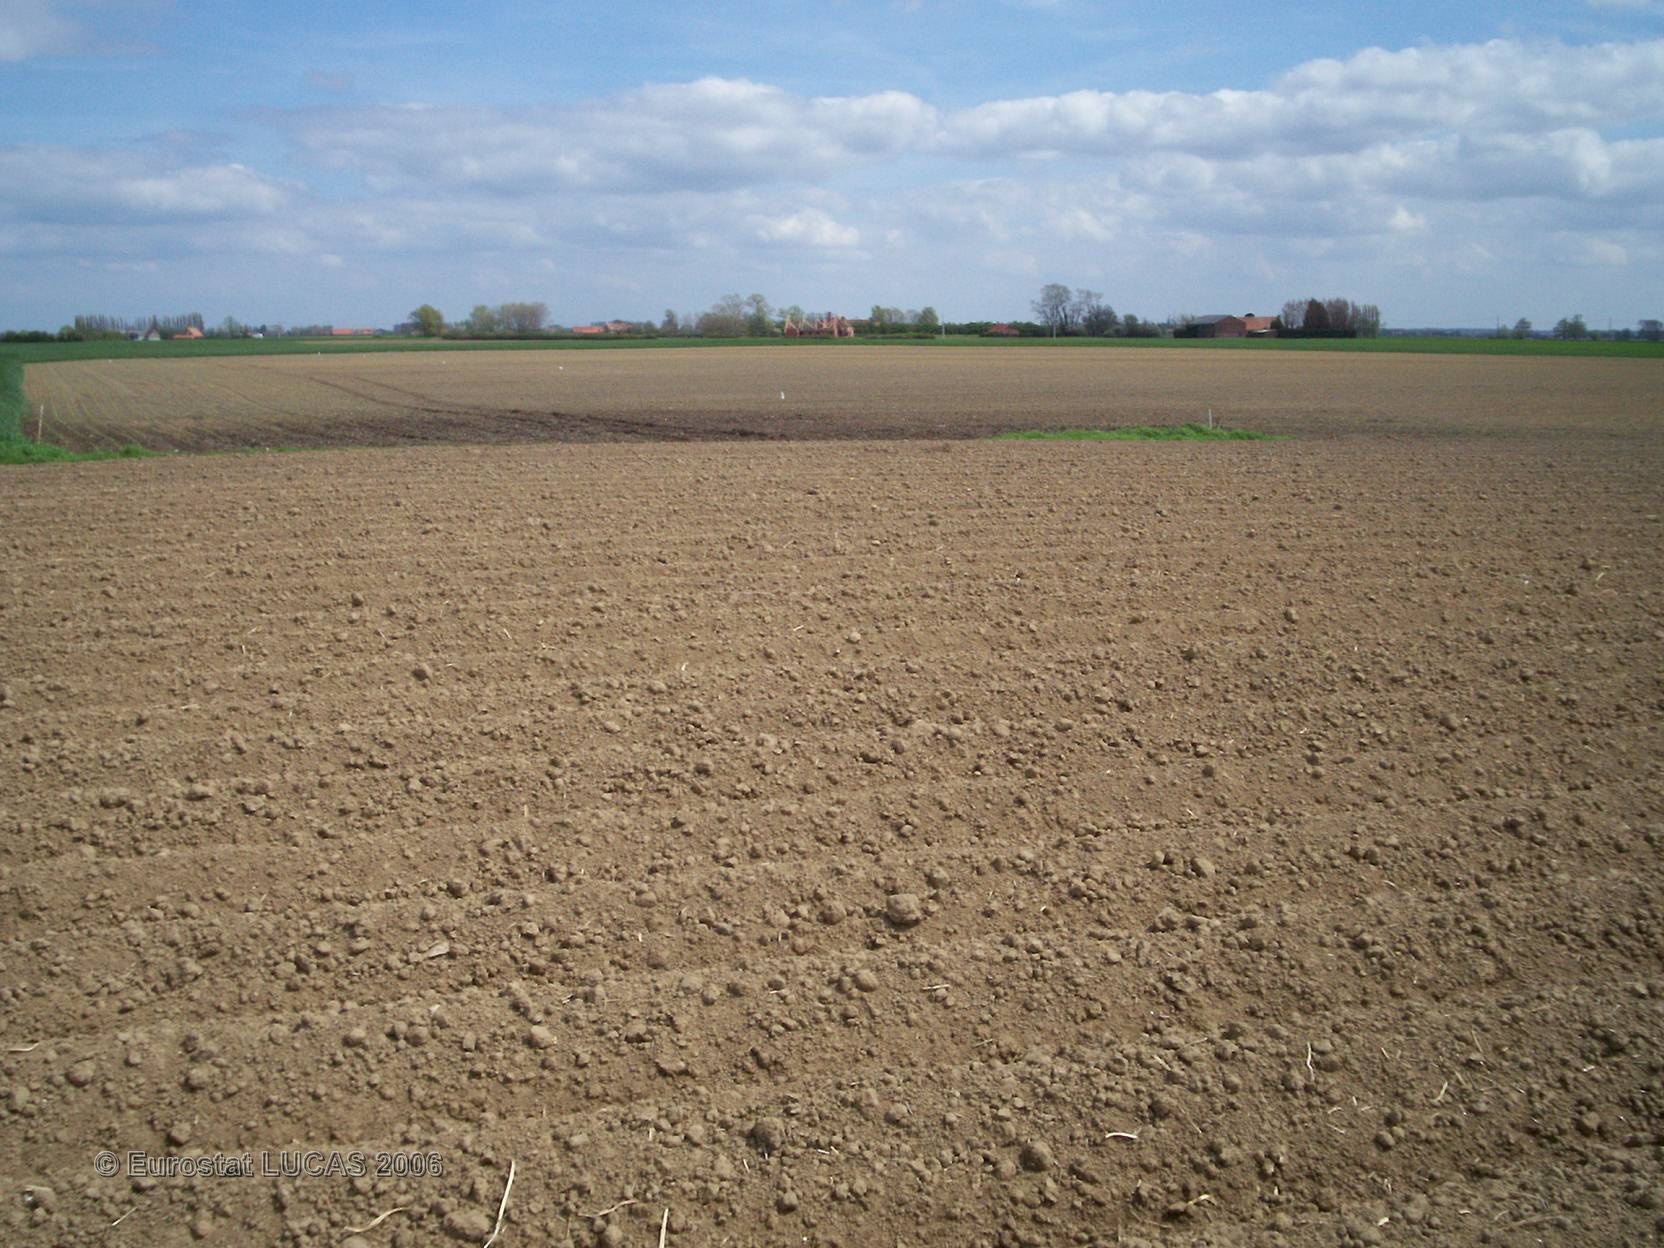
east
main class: Cropland
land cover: Potatoes
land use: Agriculture (excluding fallow land and kitchen gardens)
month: May
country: FR
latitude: 50.9333
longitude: 2.5456
